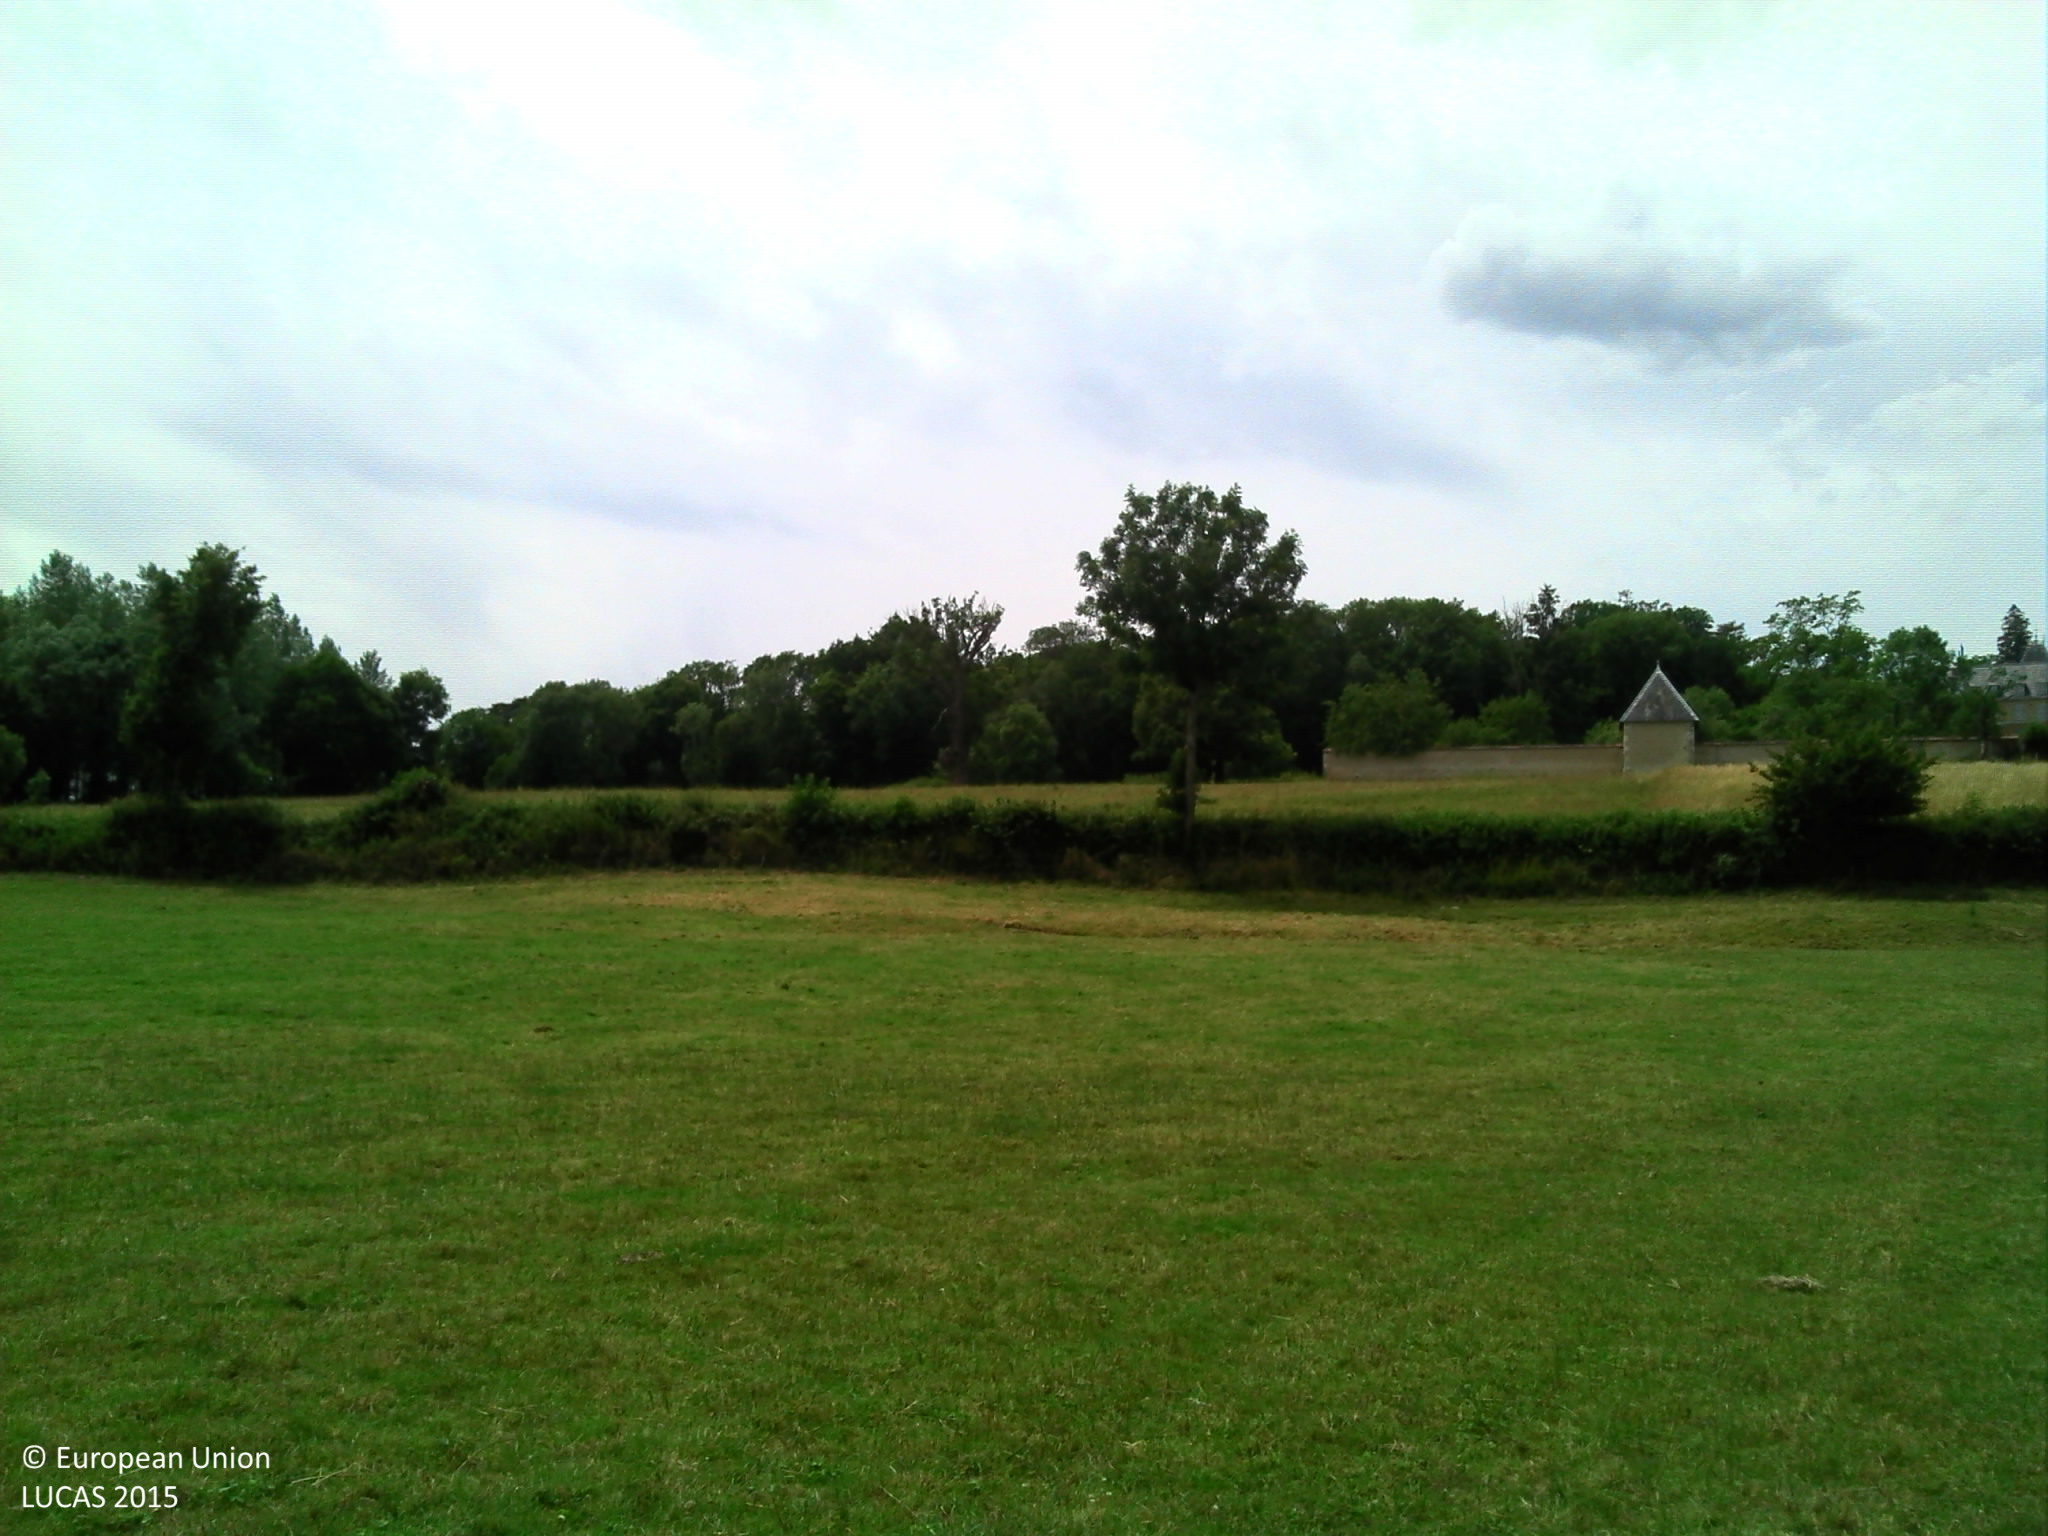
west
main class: Grassland
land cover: Grassland without tree/shrub cover
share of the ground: > 75 %
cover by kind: herbaceous plants 100 %
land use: Agriculture (excluding fallow land and kitchen gardens)
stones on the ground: < 10 %
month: June
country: FR
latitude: 46.4495
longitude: 3.3201
